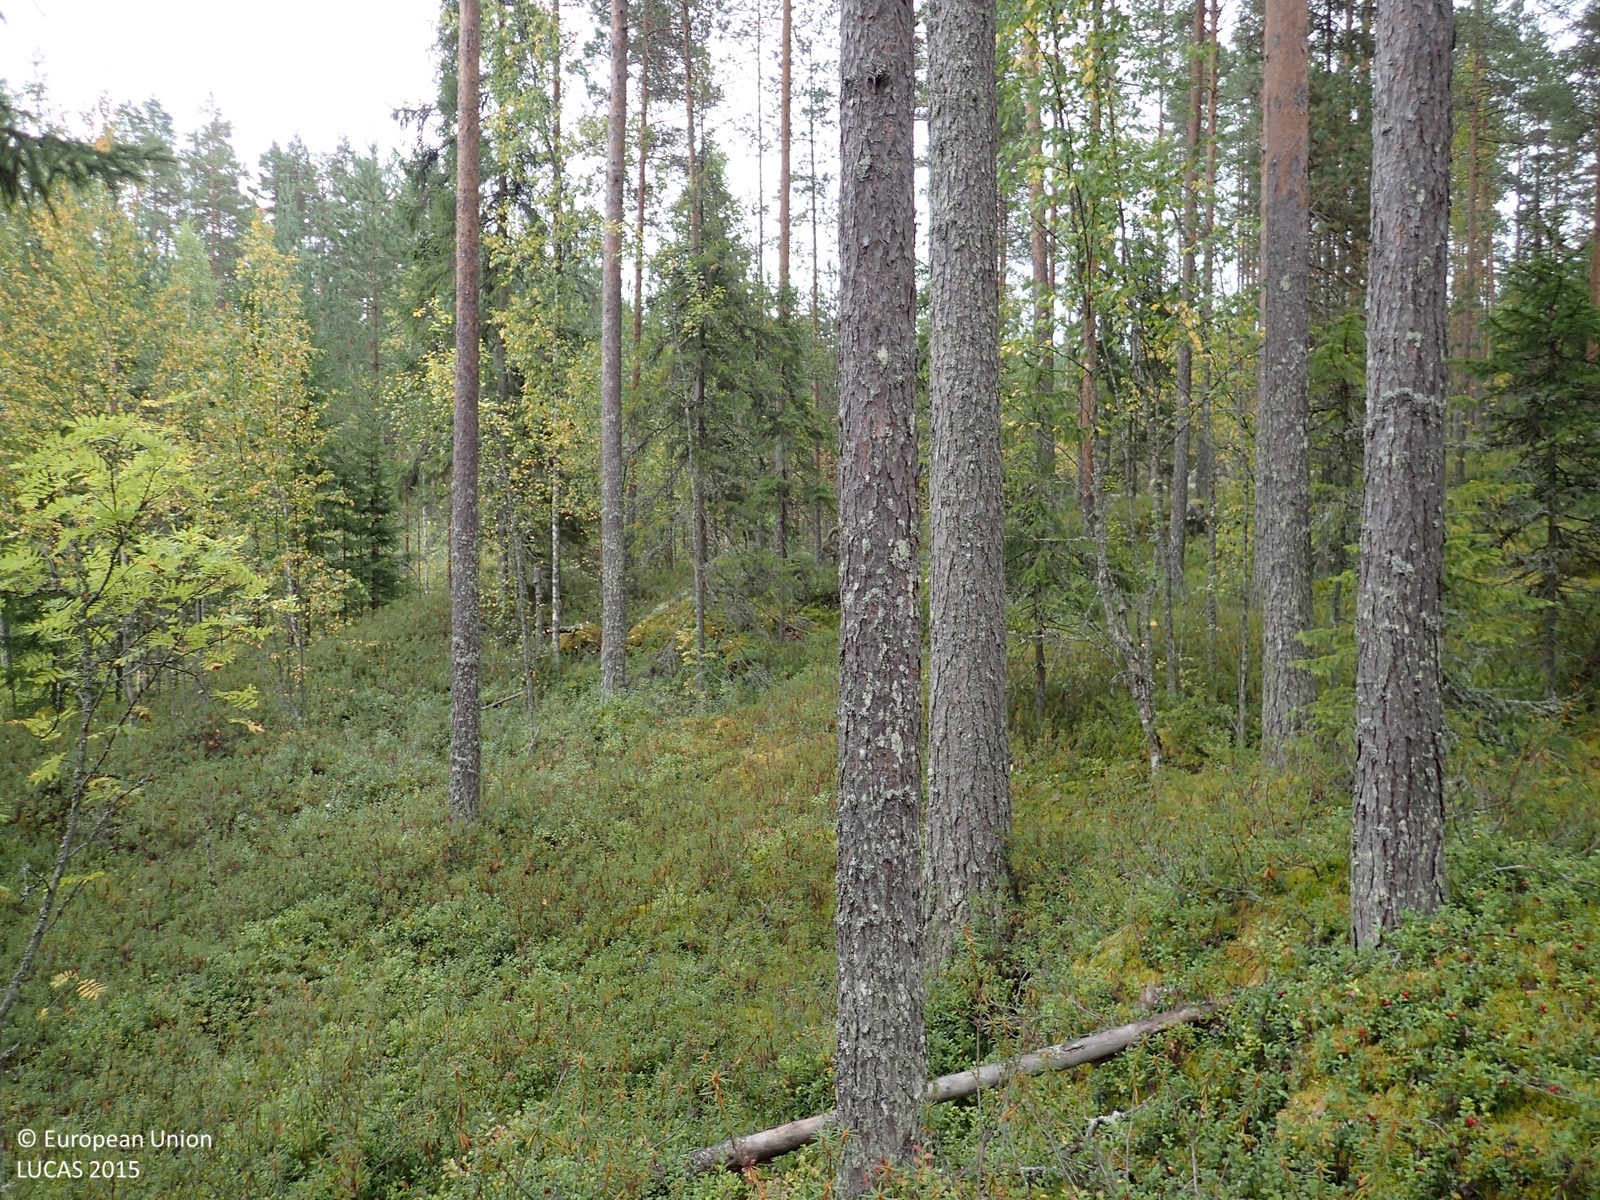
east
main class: Woodland
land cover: Pine dominated mixed woodland
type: boreal forest
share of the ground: 50 - 75 %
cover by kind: coniferous forest trees 45 %, shrubs 35 %, broadleaved forest trees 15 %, lichens and mosses 5 %
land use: Forestry
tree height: > 5 m
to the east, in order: Pine dominated mixed woodland; Electric lines; Ditches and canals; Shruby margins; Paved roads, cycling and walking lanes; Shruby margins; Ditches and canals; Pine dominated mixed woodland
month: September
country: FI
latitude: 63.1122
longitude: 26.0339
